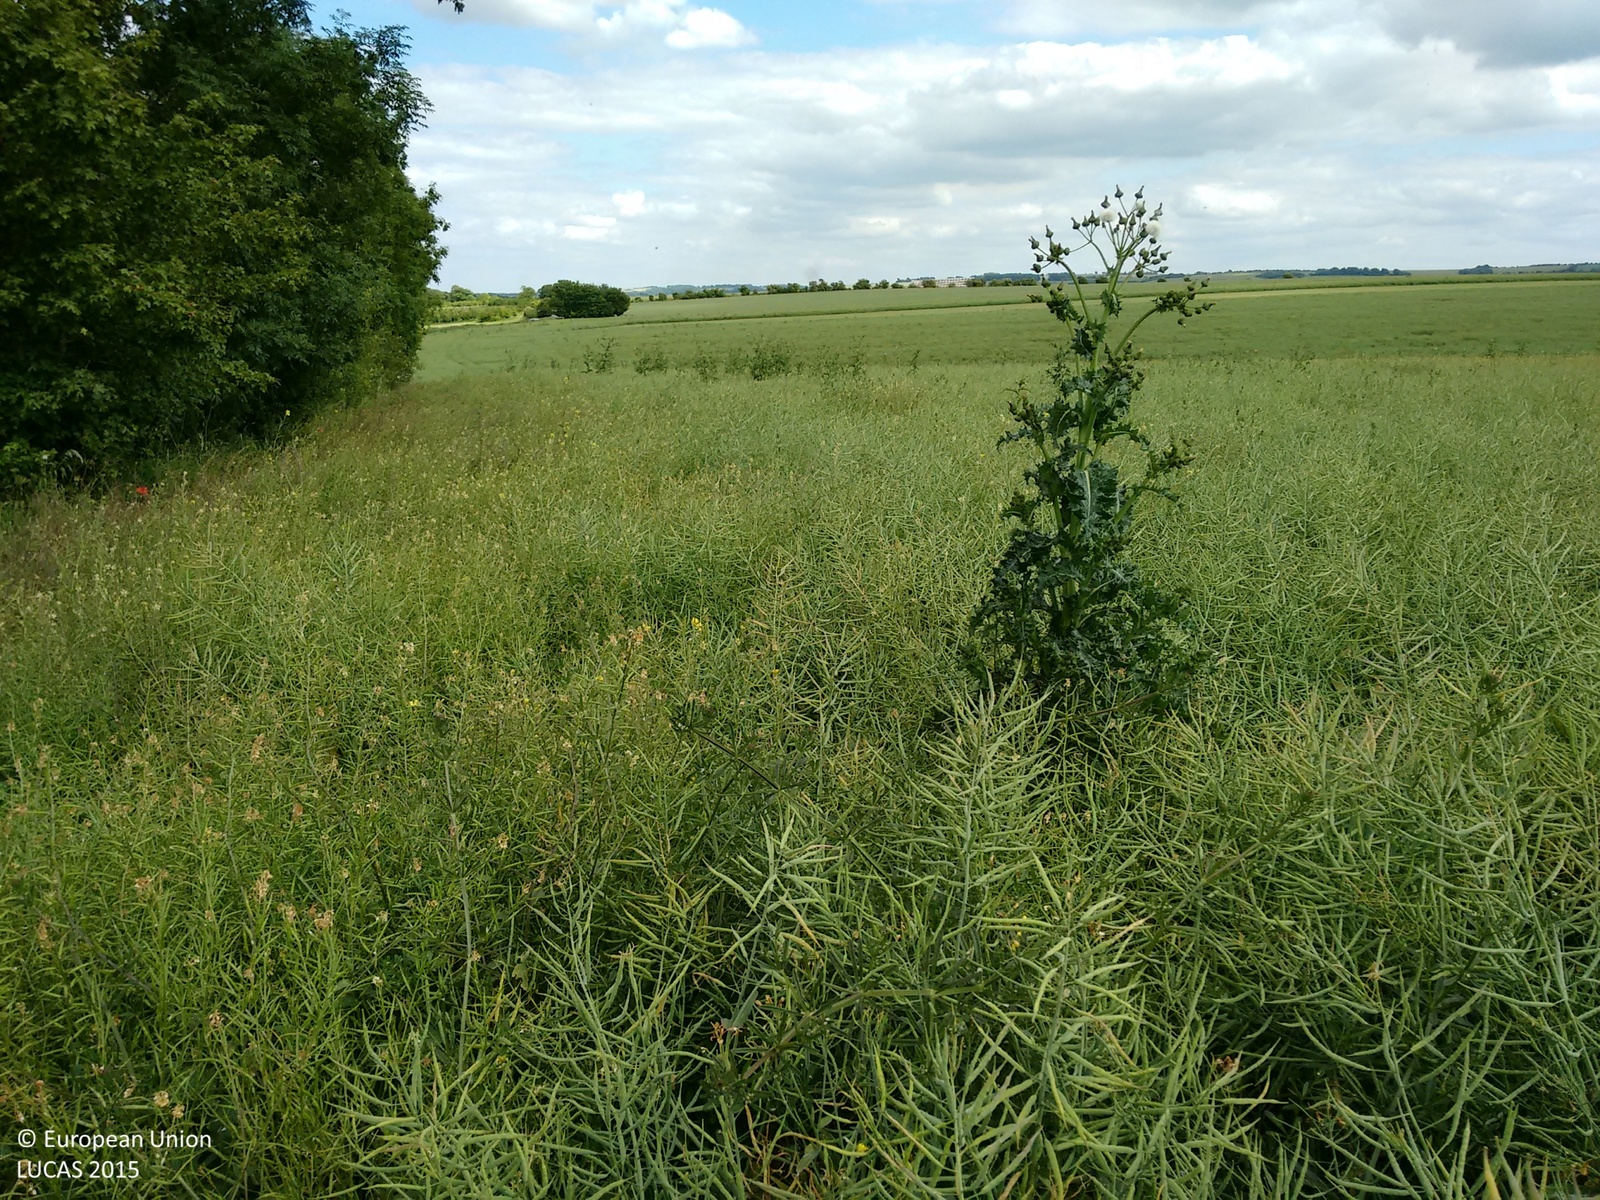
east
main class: Cropland
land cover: Rape and turnip rape
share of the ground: > 75 %
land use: Agriculture (excluding fallow land and kitchen gardens)
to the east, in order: Rape and turnip rape
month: June
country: GB
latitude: 51.5808
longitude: -1.4950
